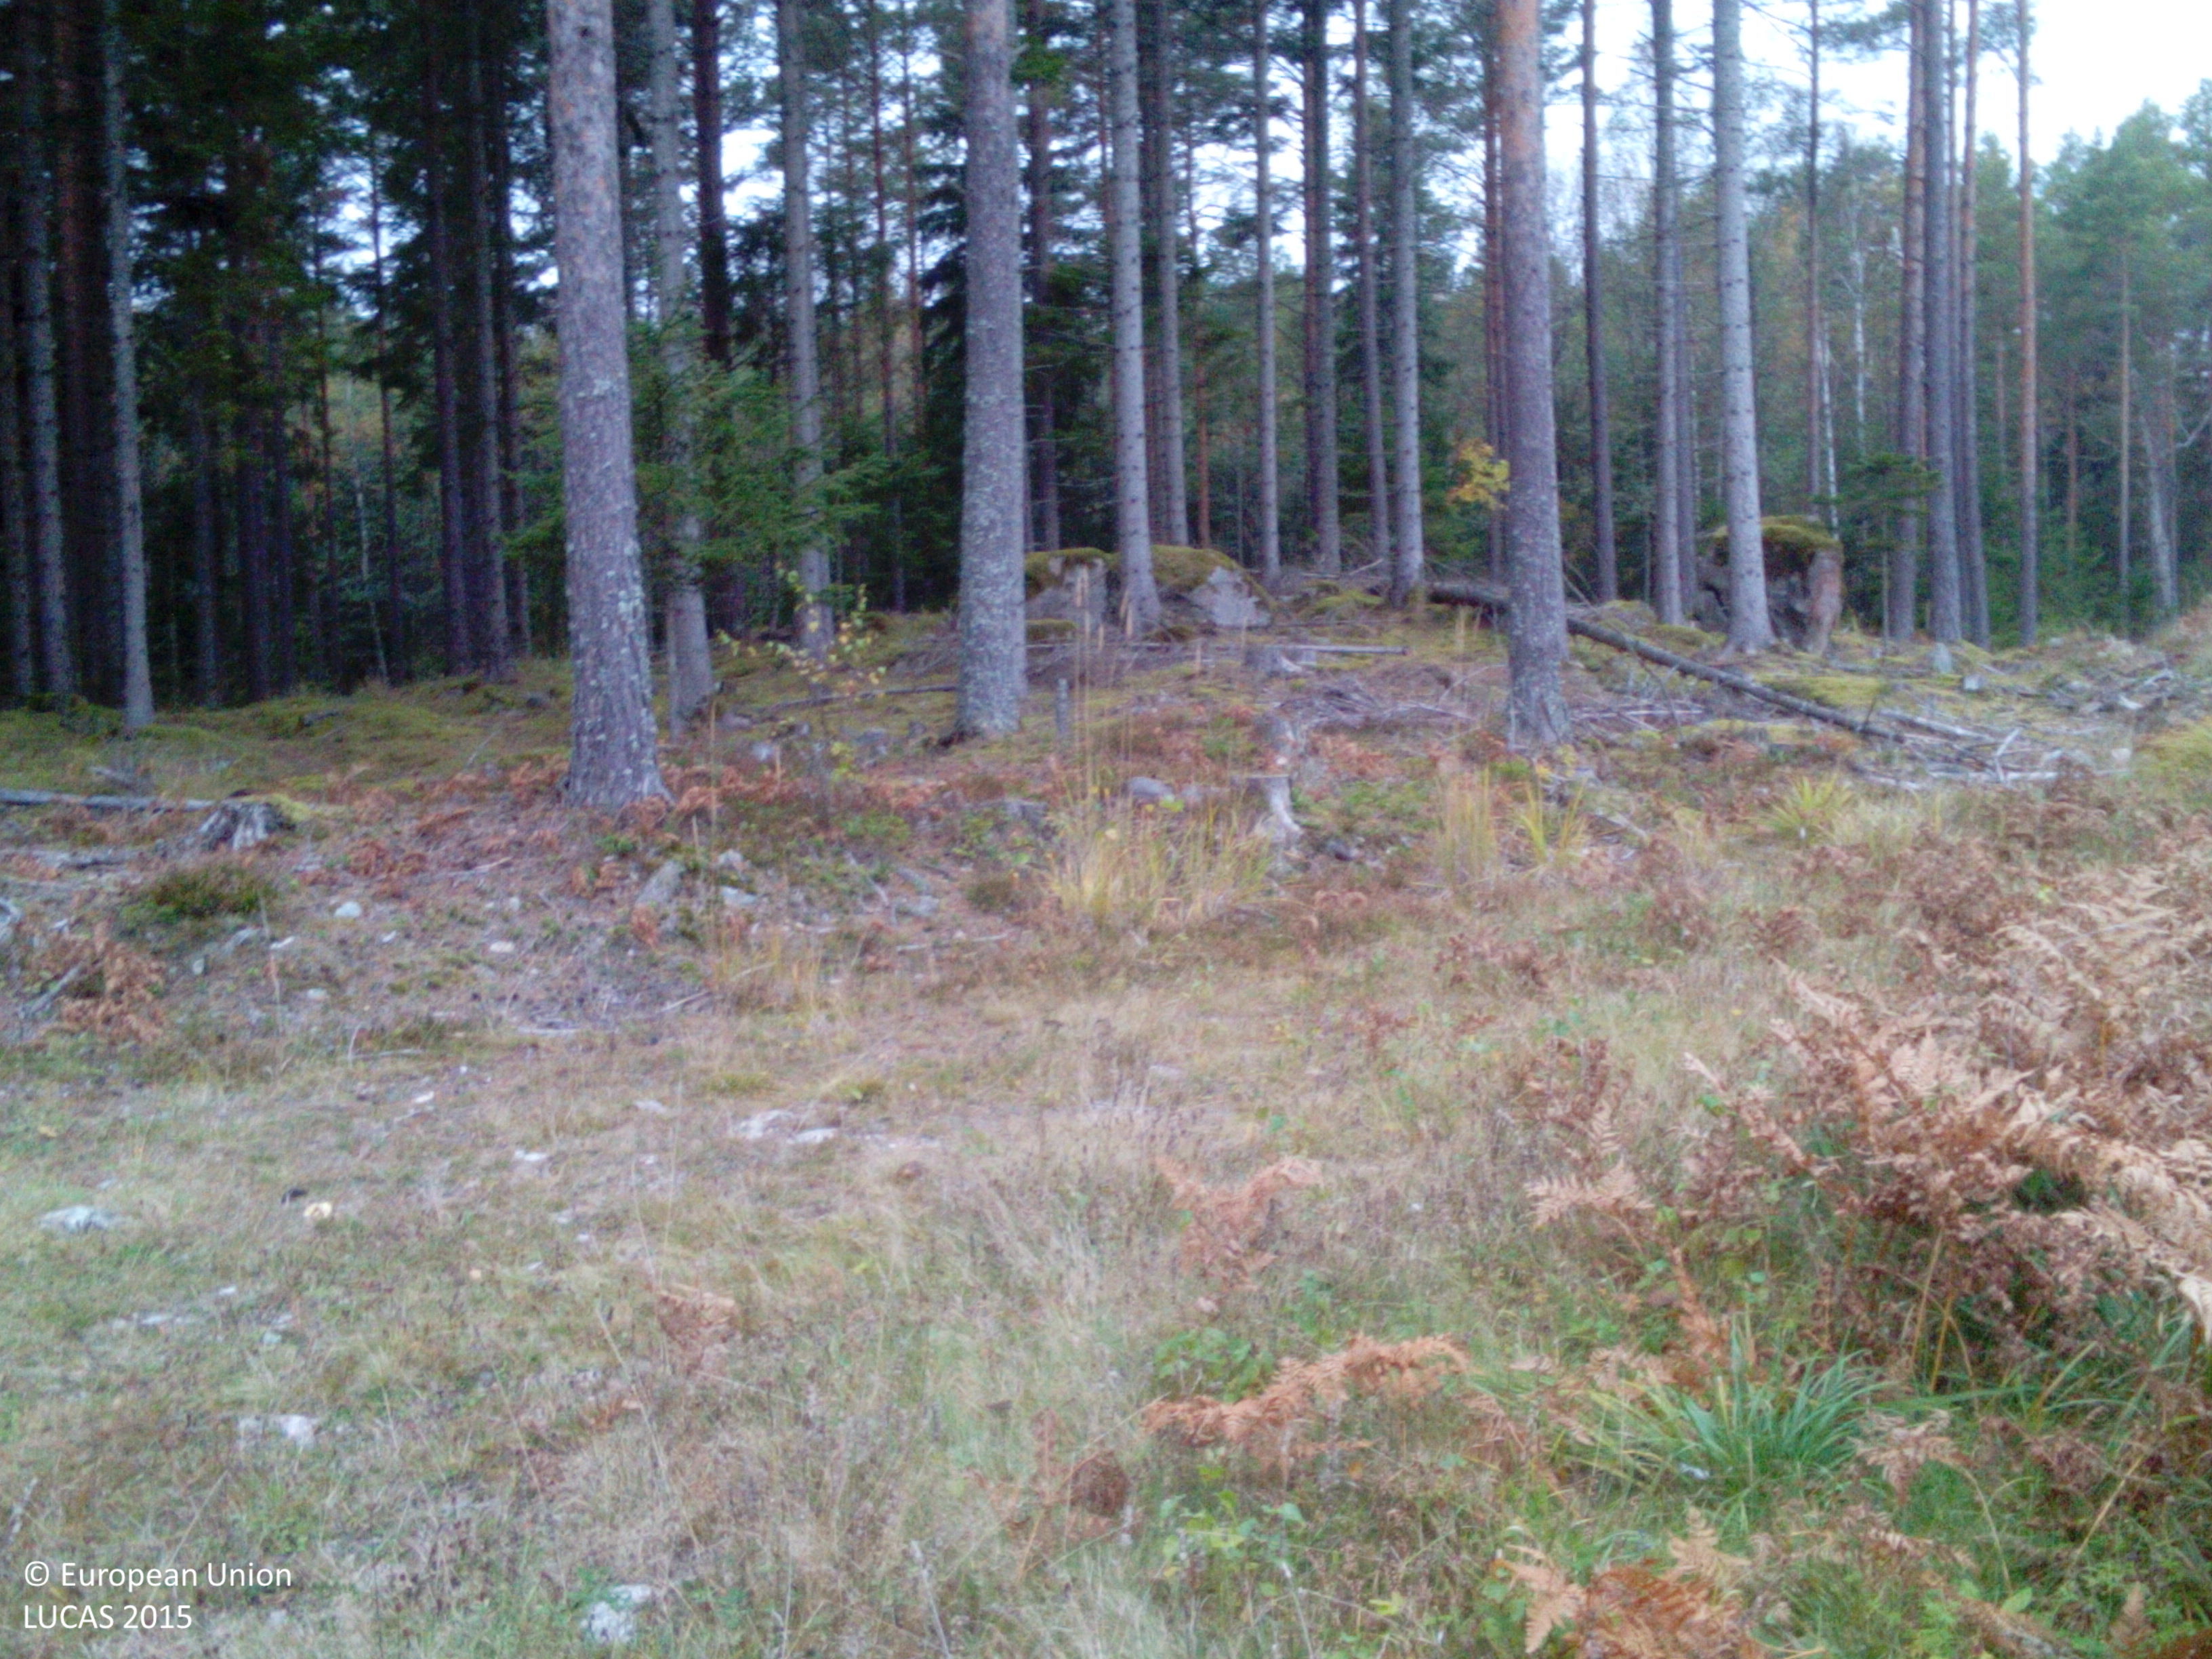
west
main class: Grassland
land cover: Grassland without tree/shrub cover
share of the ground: > 75 %
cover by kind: herbaceous plants 100 %
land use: Semi-natural and natural areas not in use
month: October
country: SE
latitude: 58.8081
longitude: 16.3826
